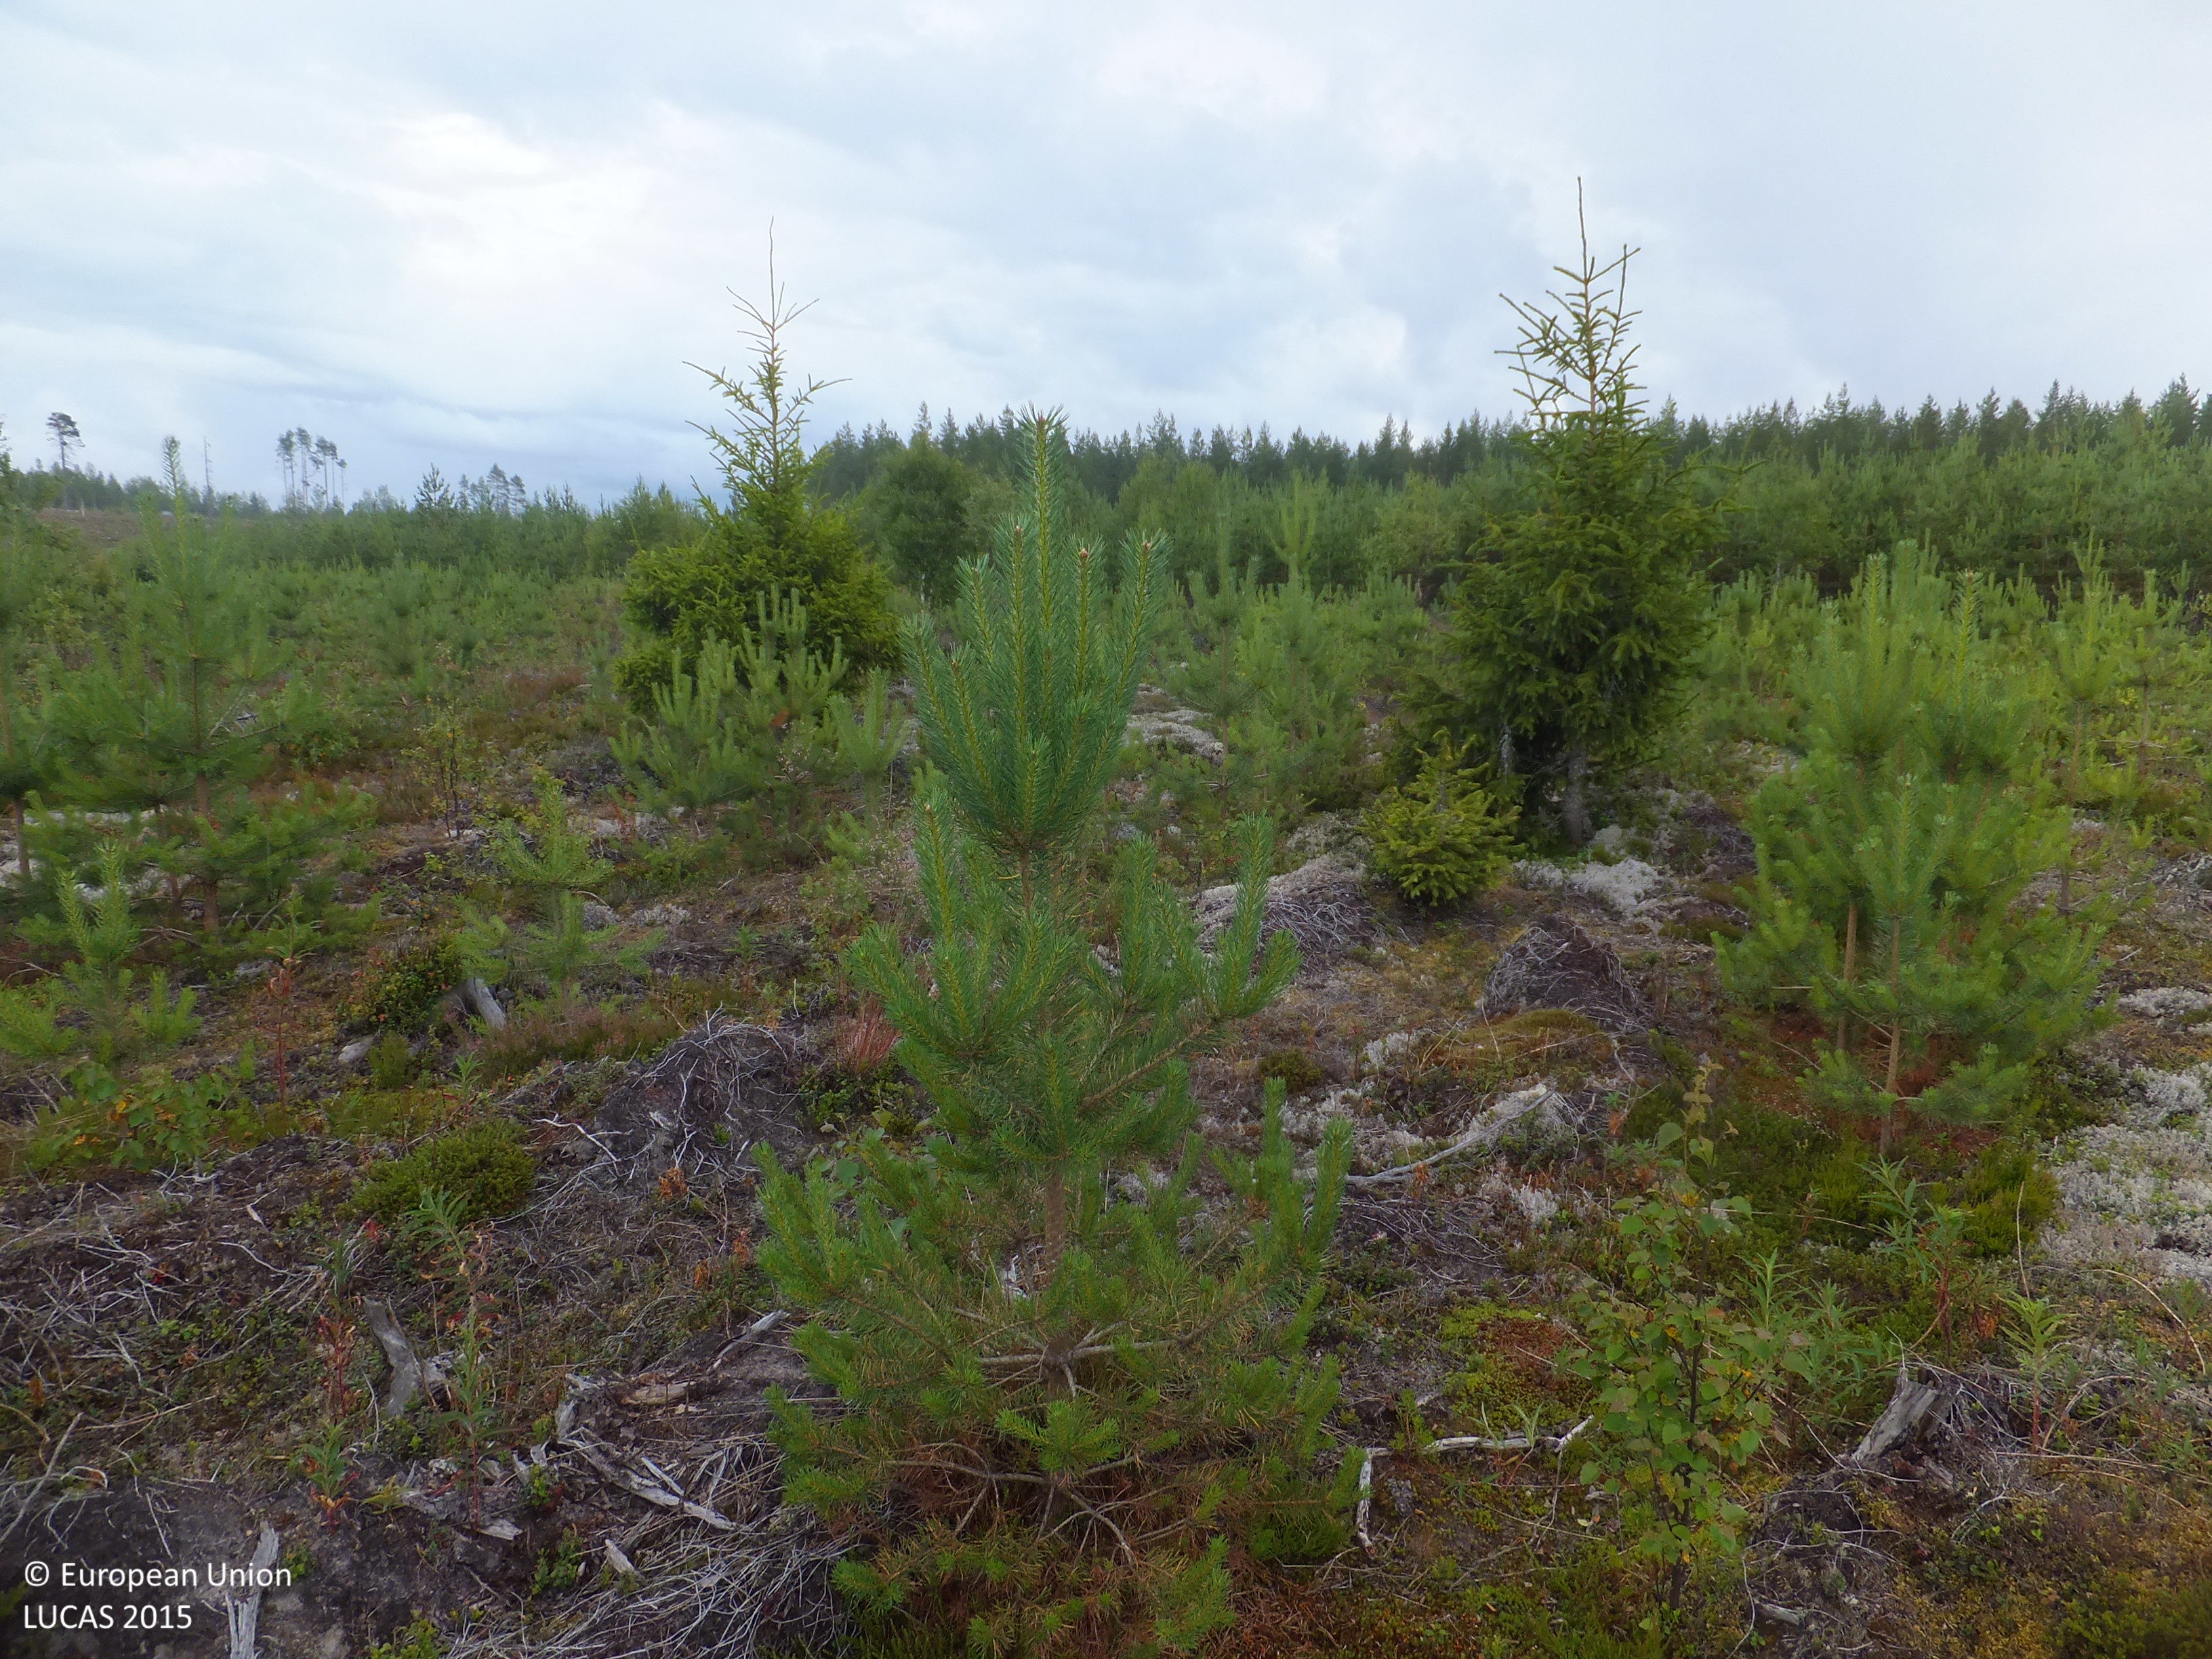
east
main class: Woodland
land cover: Pine dominated coniferous woodland
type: boreal forest
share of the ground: 25 - 50 %
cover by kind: coniferous forest trees 25 %, shrubs 20 %, lichens and mosses 20 %, unconsolidated bare surface 20 %, herbaceous plants 10 %, broadleaved forest trees 5 %
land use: Forestry
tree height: < 5 m
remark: Nursery
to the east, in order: Pine dominated coniferous woodland
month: July
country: FI
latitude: 63.6040
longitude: 23.4266
